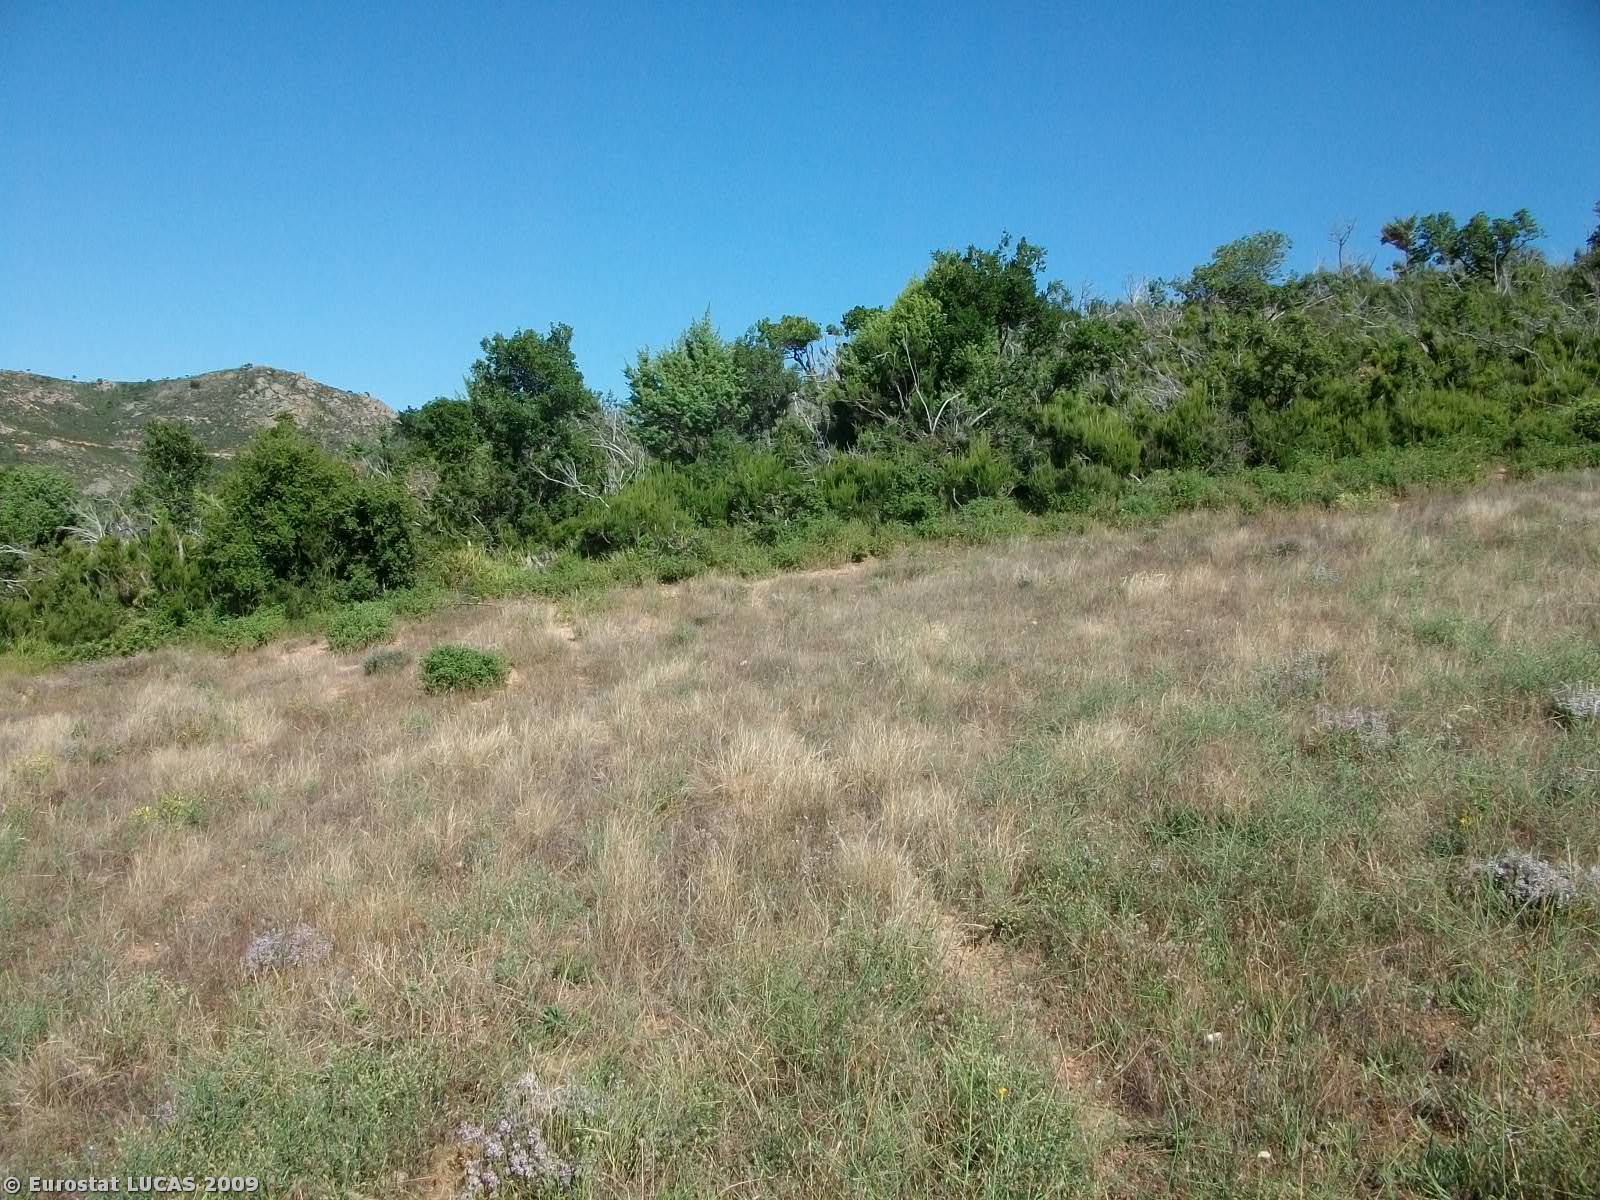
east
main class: Grassland
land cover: Spontaneously vegetated surfaces
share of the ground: > 75 %
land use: Fallow land
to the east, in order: Spontaneously vegetated surfaces; Shrubland with sparse tree cover; Tracks; Bare land; Shrubland with sparse tree cover
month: July
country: GR
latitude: 40.5015
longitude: 23.4998
